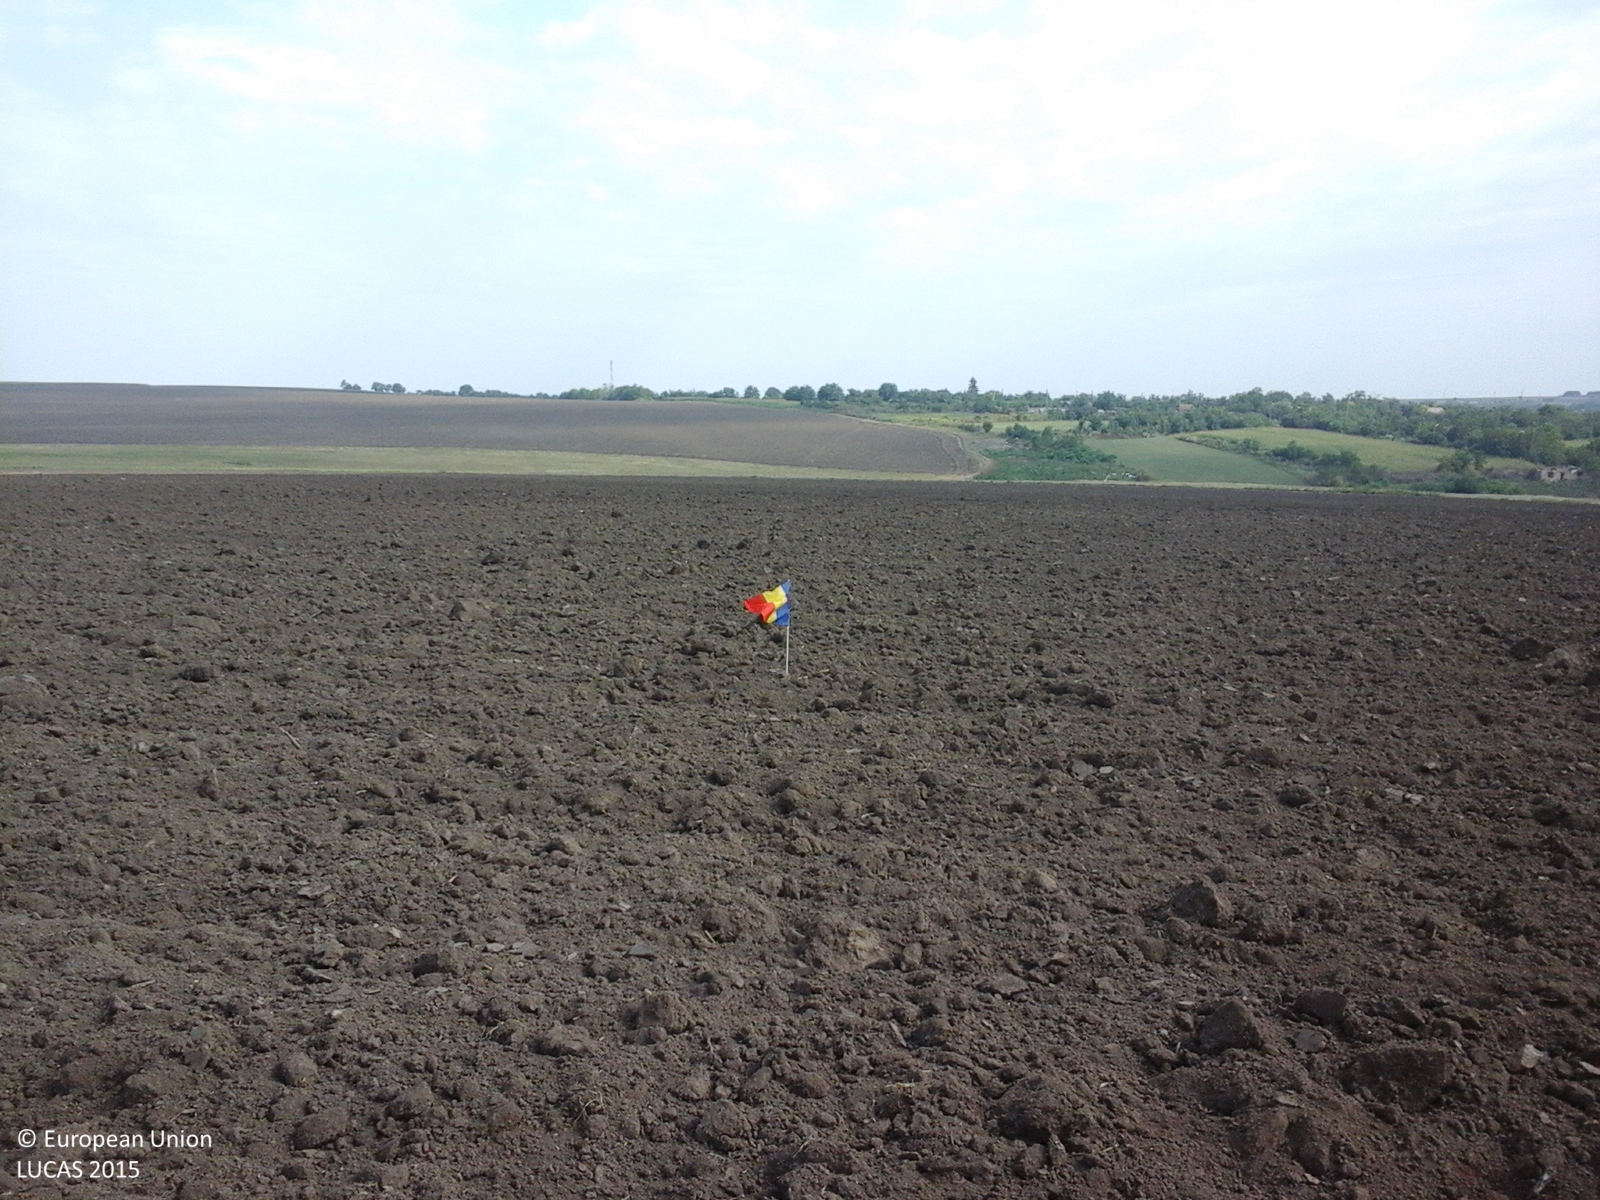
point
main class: Cropland
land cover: Common wheat
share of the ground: < 10 %
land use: Agriculture (excluding fallow land and kitchen gardens)
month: August
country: RO
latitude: 43.8140
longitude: 28.0919
